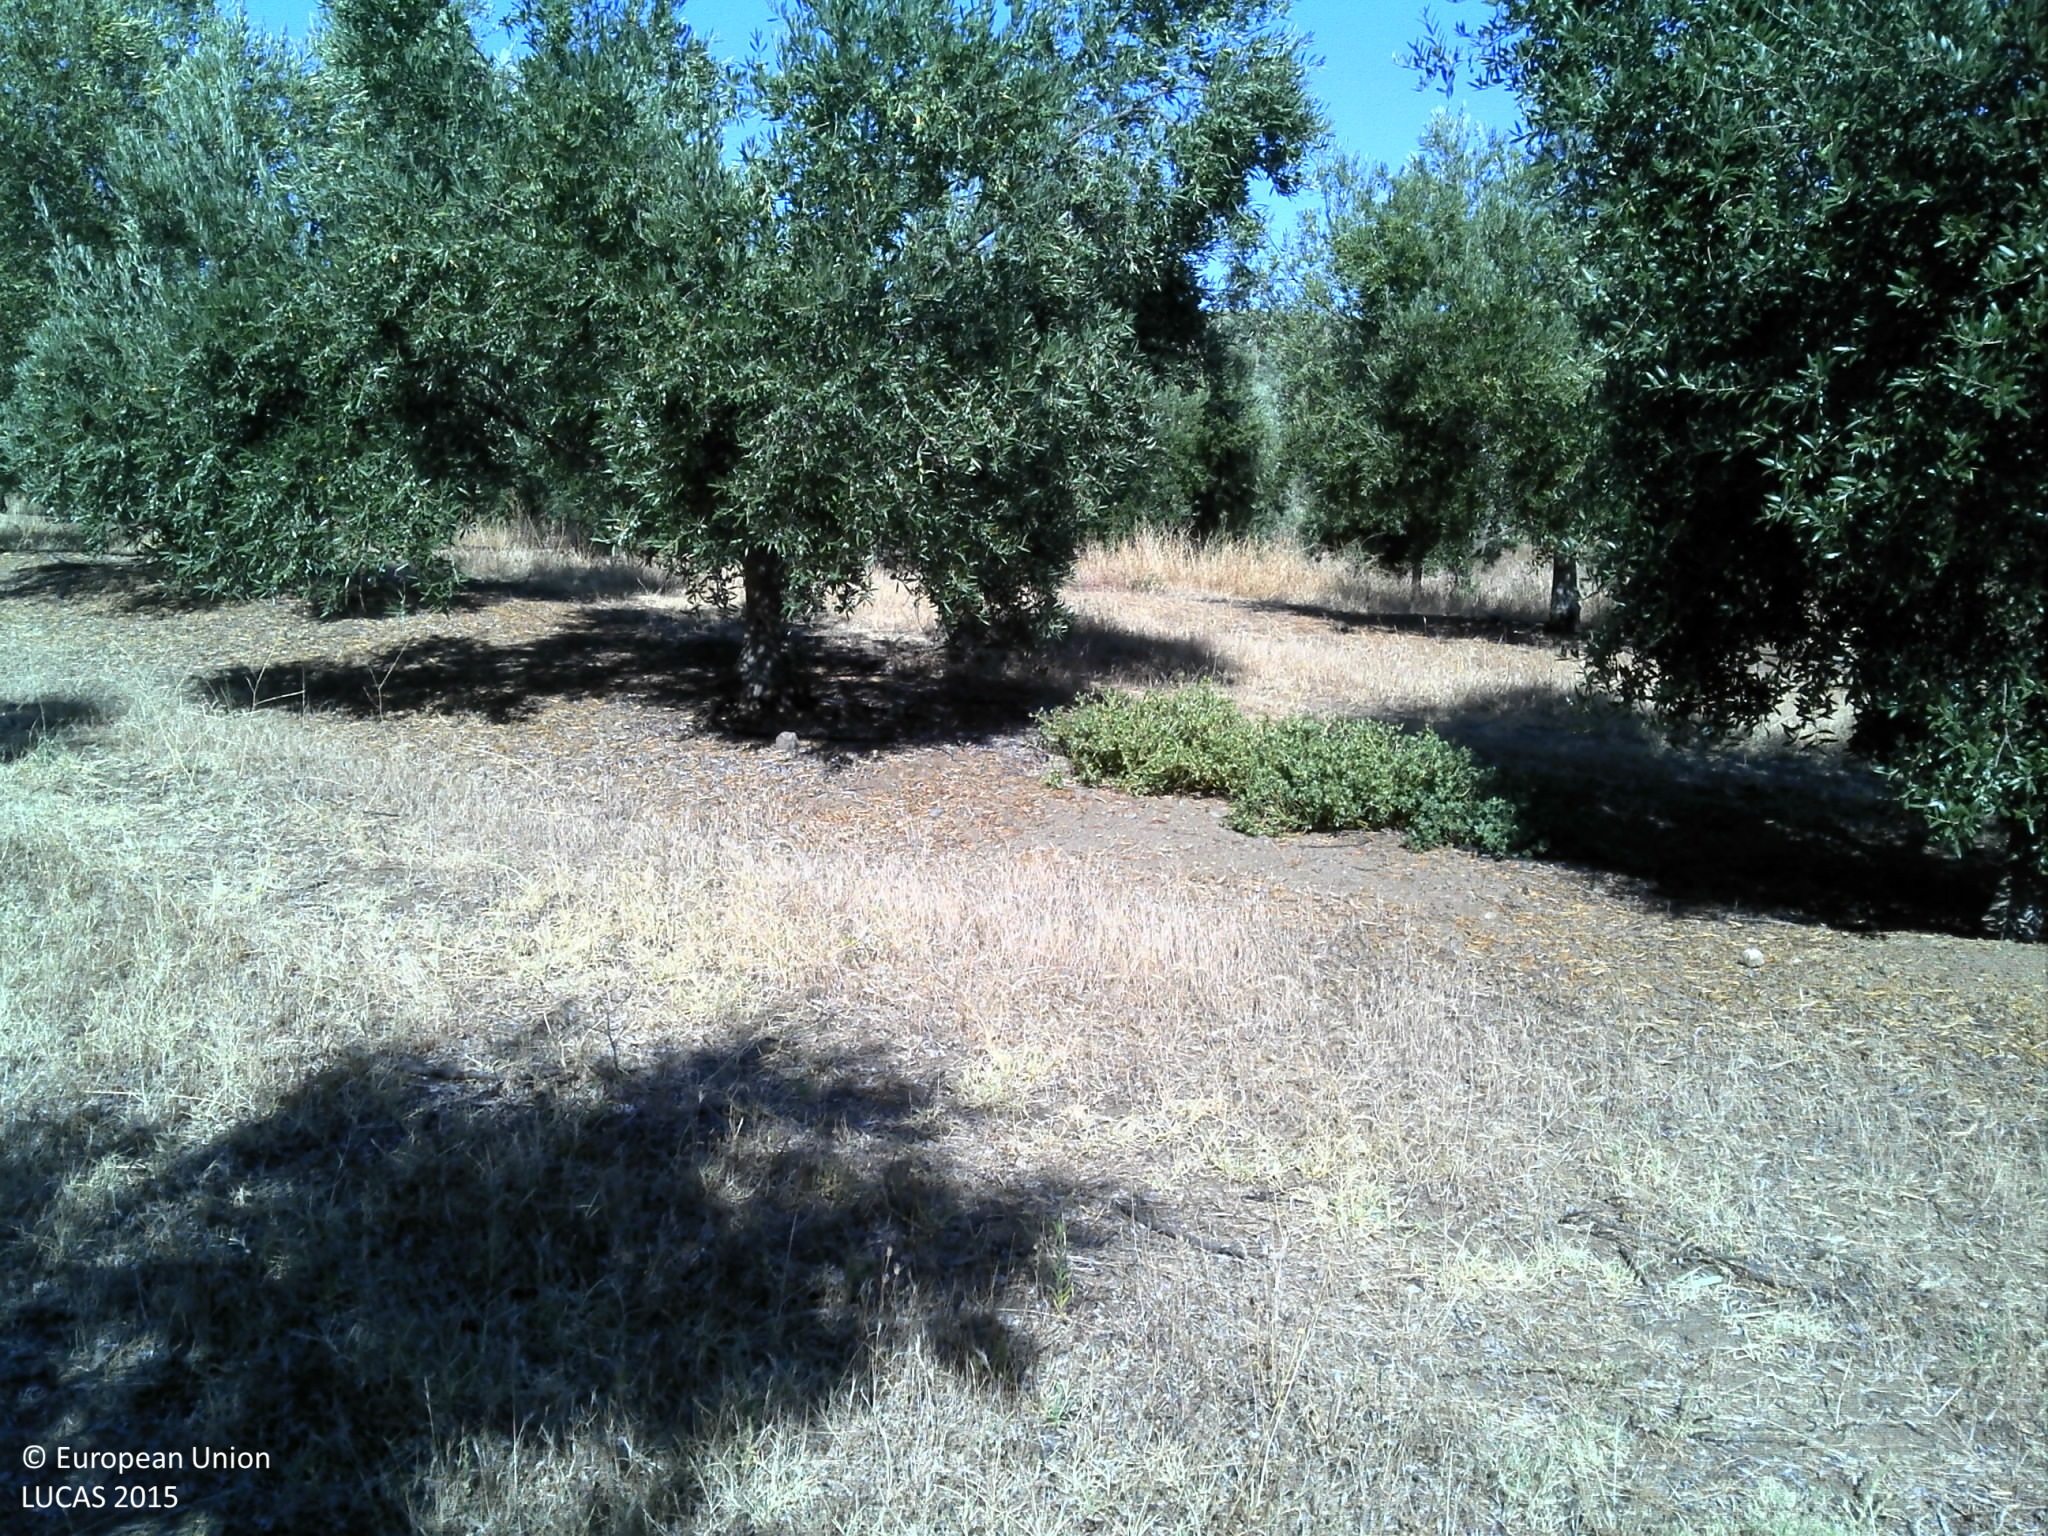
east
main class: Cropland
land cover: Olive groves
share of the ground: 50 - 75 %
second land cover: Grassland without tree/shrub cover
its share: 25 - 50 %
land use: Agriculture (excluding fallow land and kitchen gardens)
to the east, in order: Olive groves; Grassland without tree/shrub cover; Ditches and canals; Grass margins; Other bare soil; Tracks; Olive groves
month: July
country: PT
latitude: 37.9776
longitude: -7.7034
